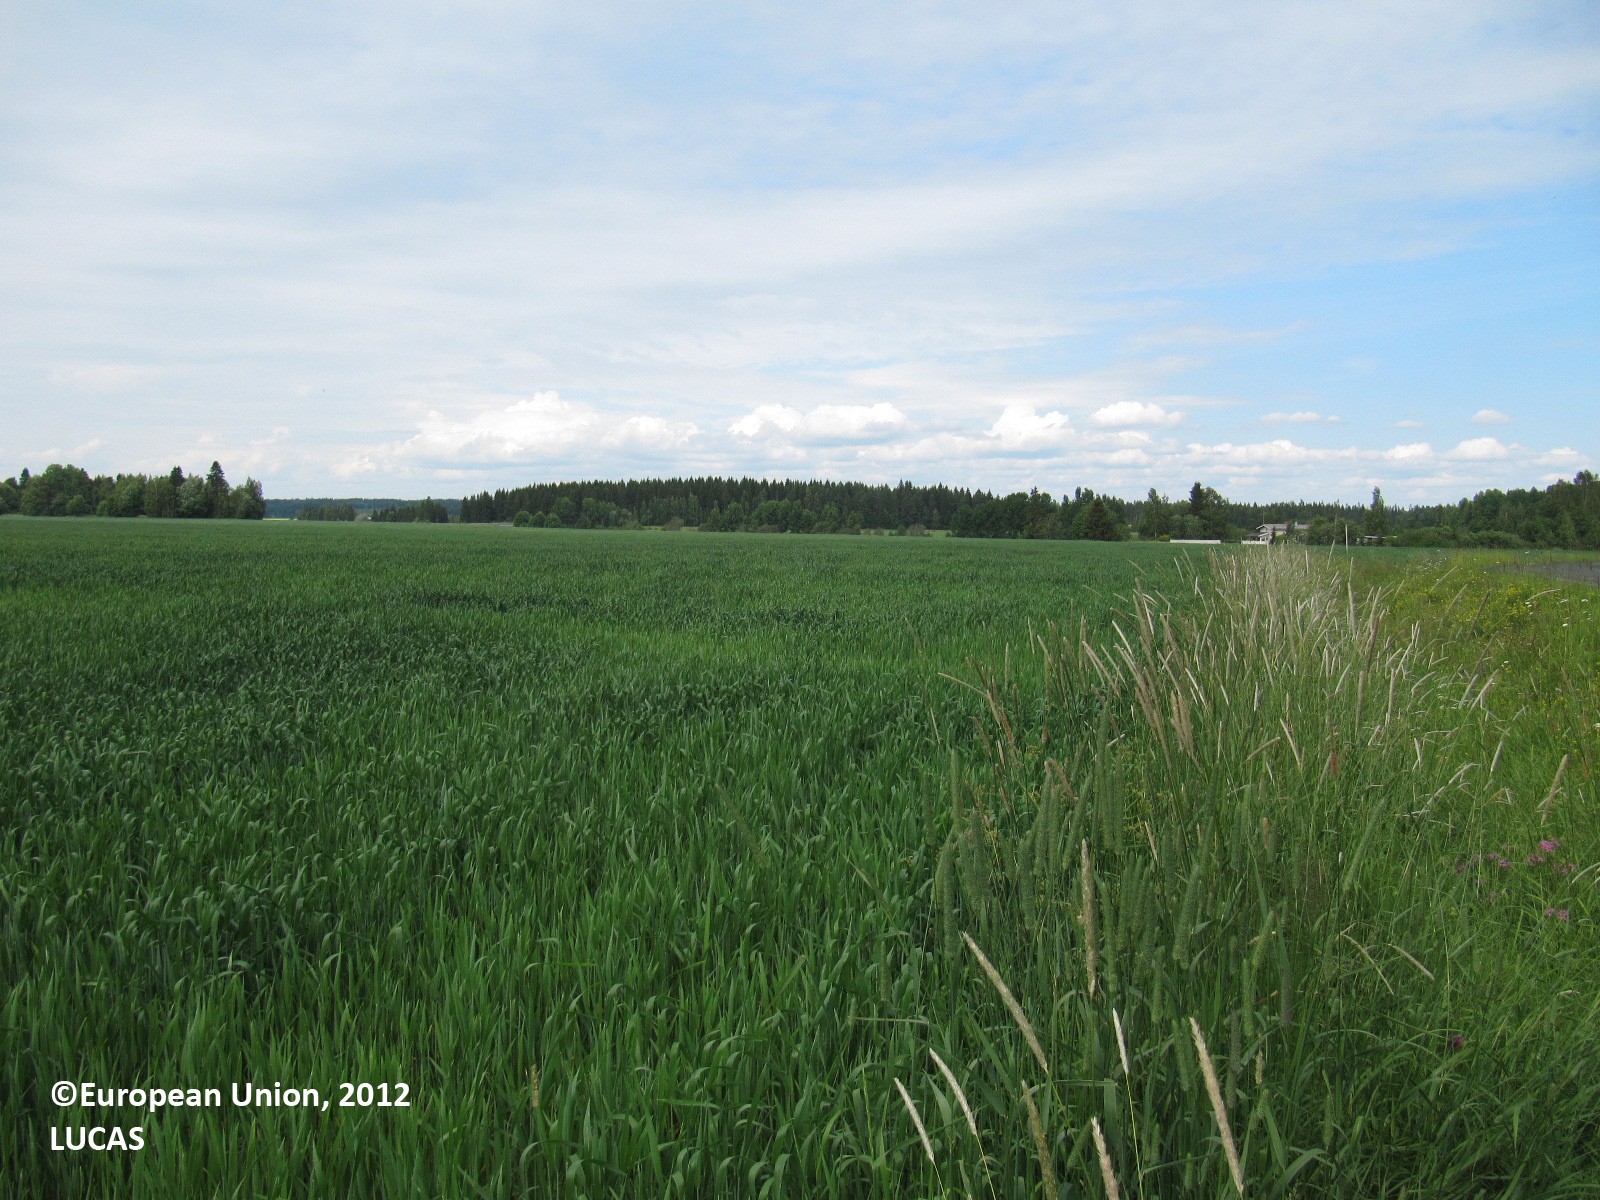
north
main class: Cropland
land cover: Common wheat
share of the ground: > 75 %
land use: Agriculture (excluding fallow land and kitchen gardens)
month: July
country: FI
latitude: 60.9511
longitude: 23.3555
